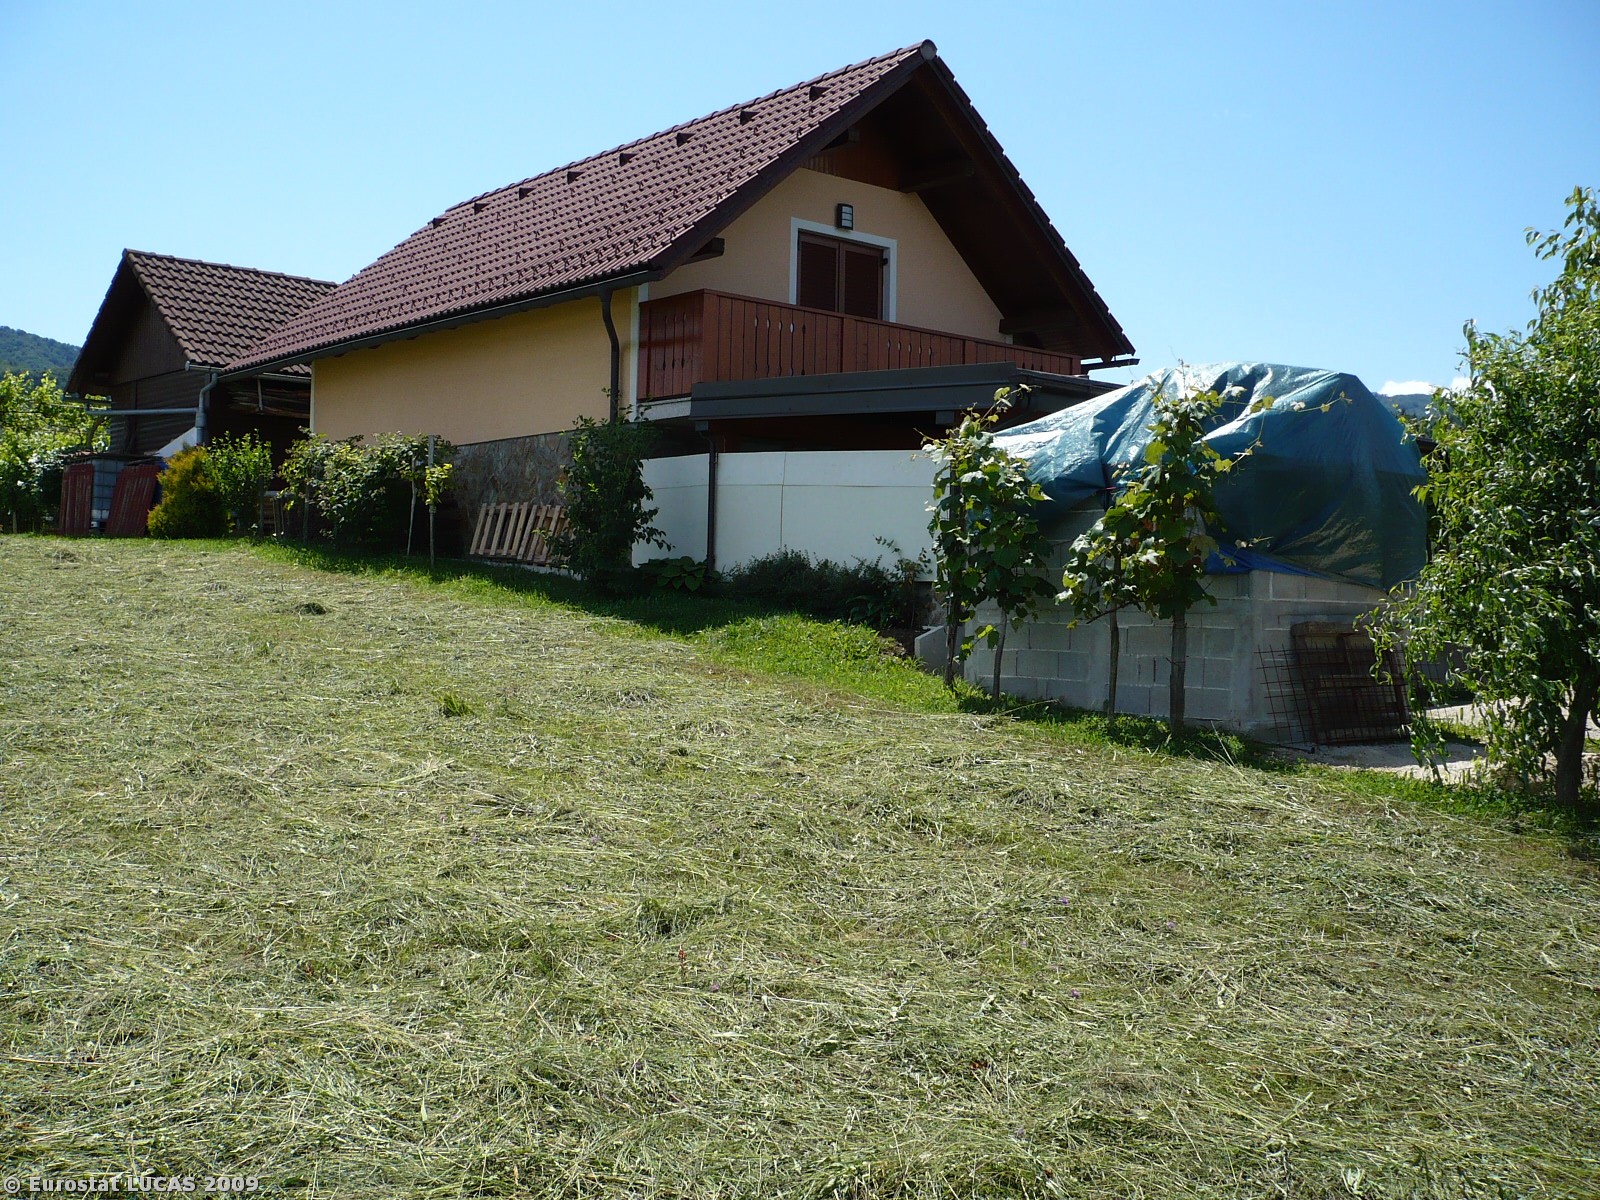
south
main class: Grassland
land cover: Grassland without tree/shrub cover
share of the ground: > 75 %
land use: Agriculture (excluding fallow land and kitchen gardens)
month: June
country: SI
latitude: 45.8208
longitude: 15.3383
